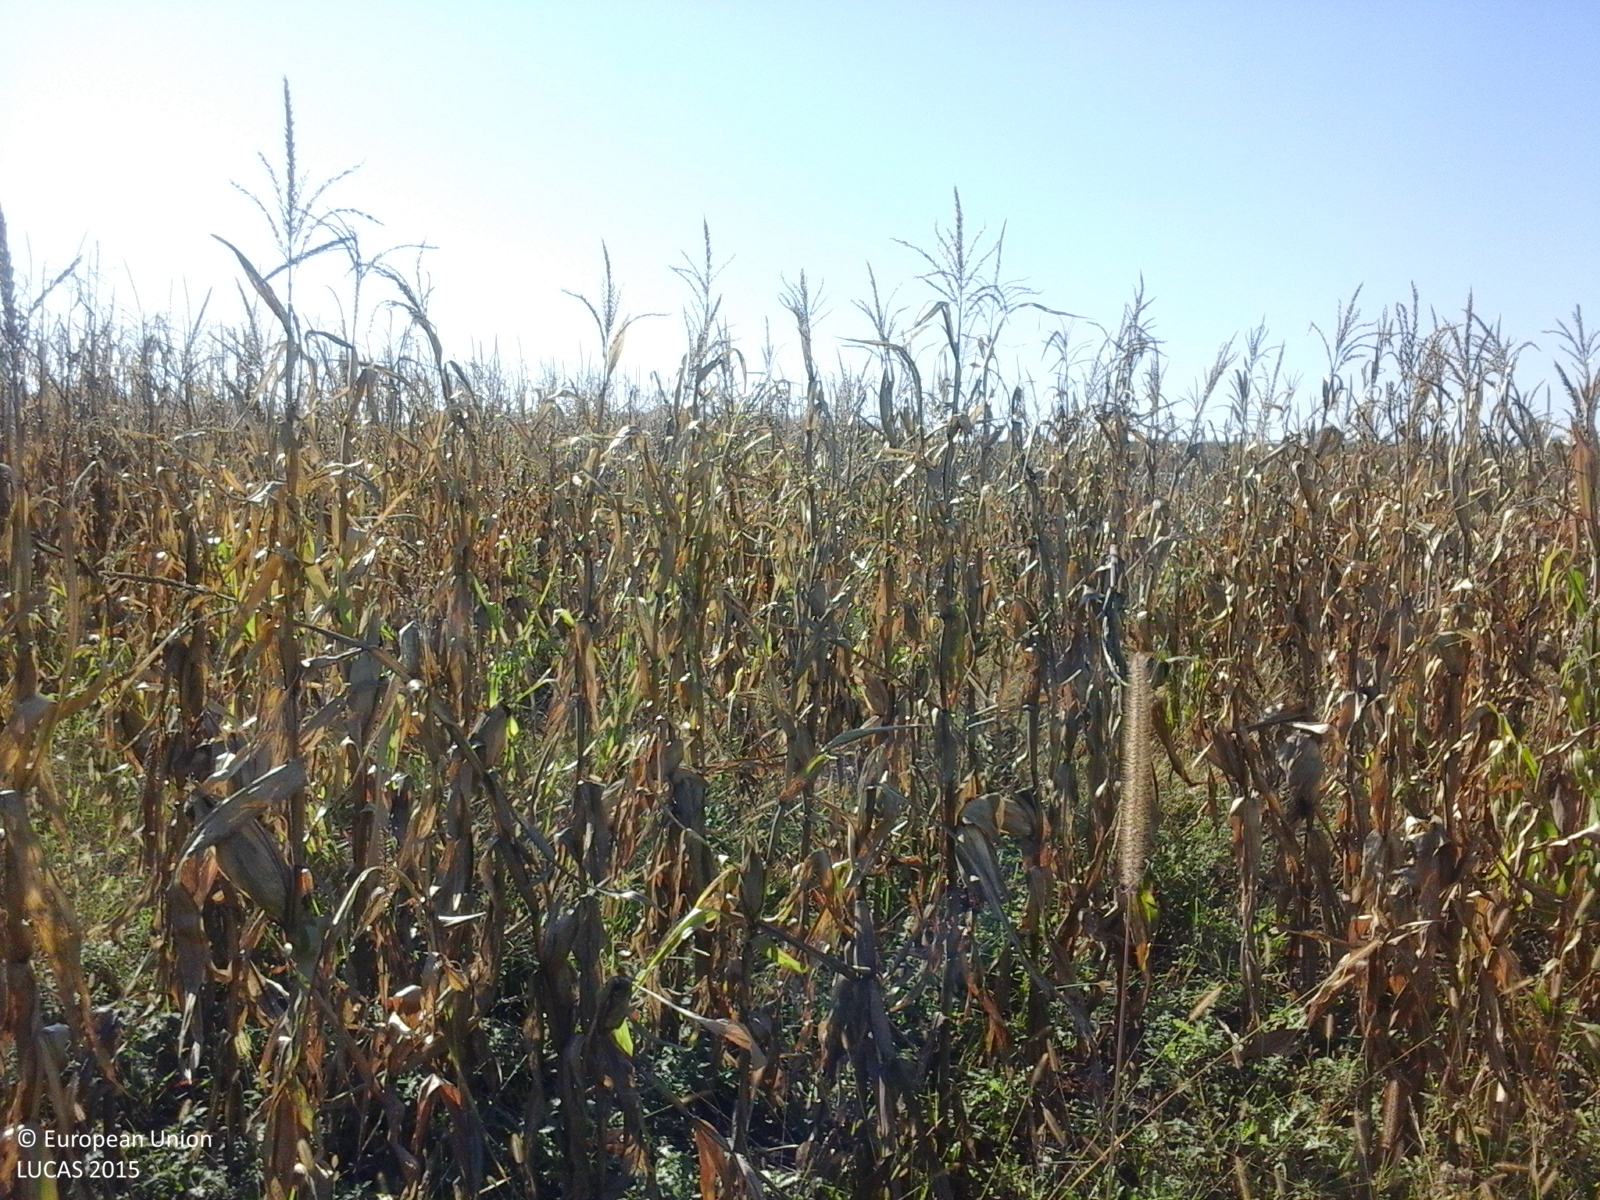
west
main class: Cropland
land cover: Maize
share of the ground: > 75 %
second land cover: Spontaneously vegetated surfaces
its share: > 75 %
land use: Agriculture (excluding fallow land and kitchen gardens)
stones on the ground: < 10 %
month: October
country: RO
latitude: 46.1479
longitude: 23.7813
